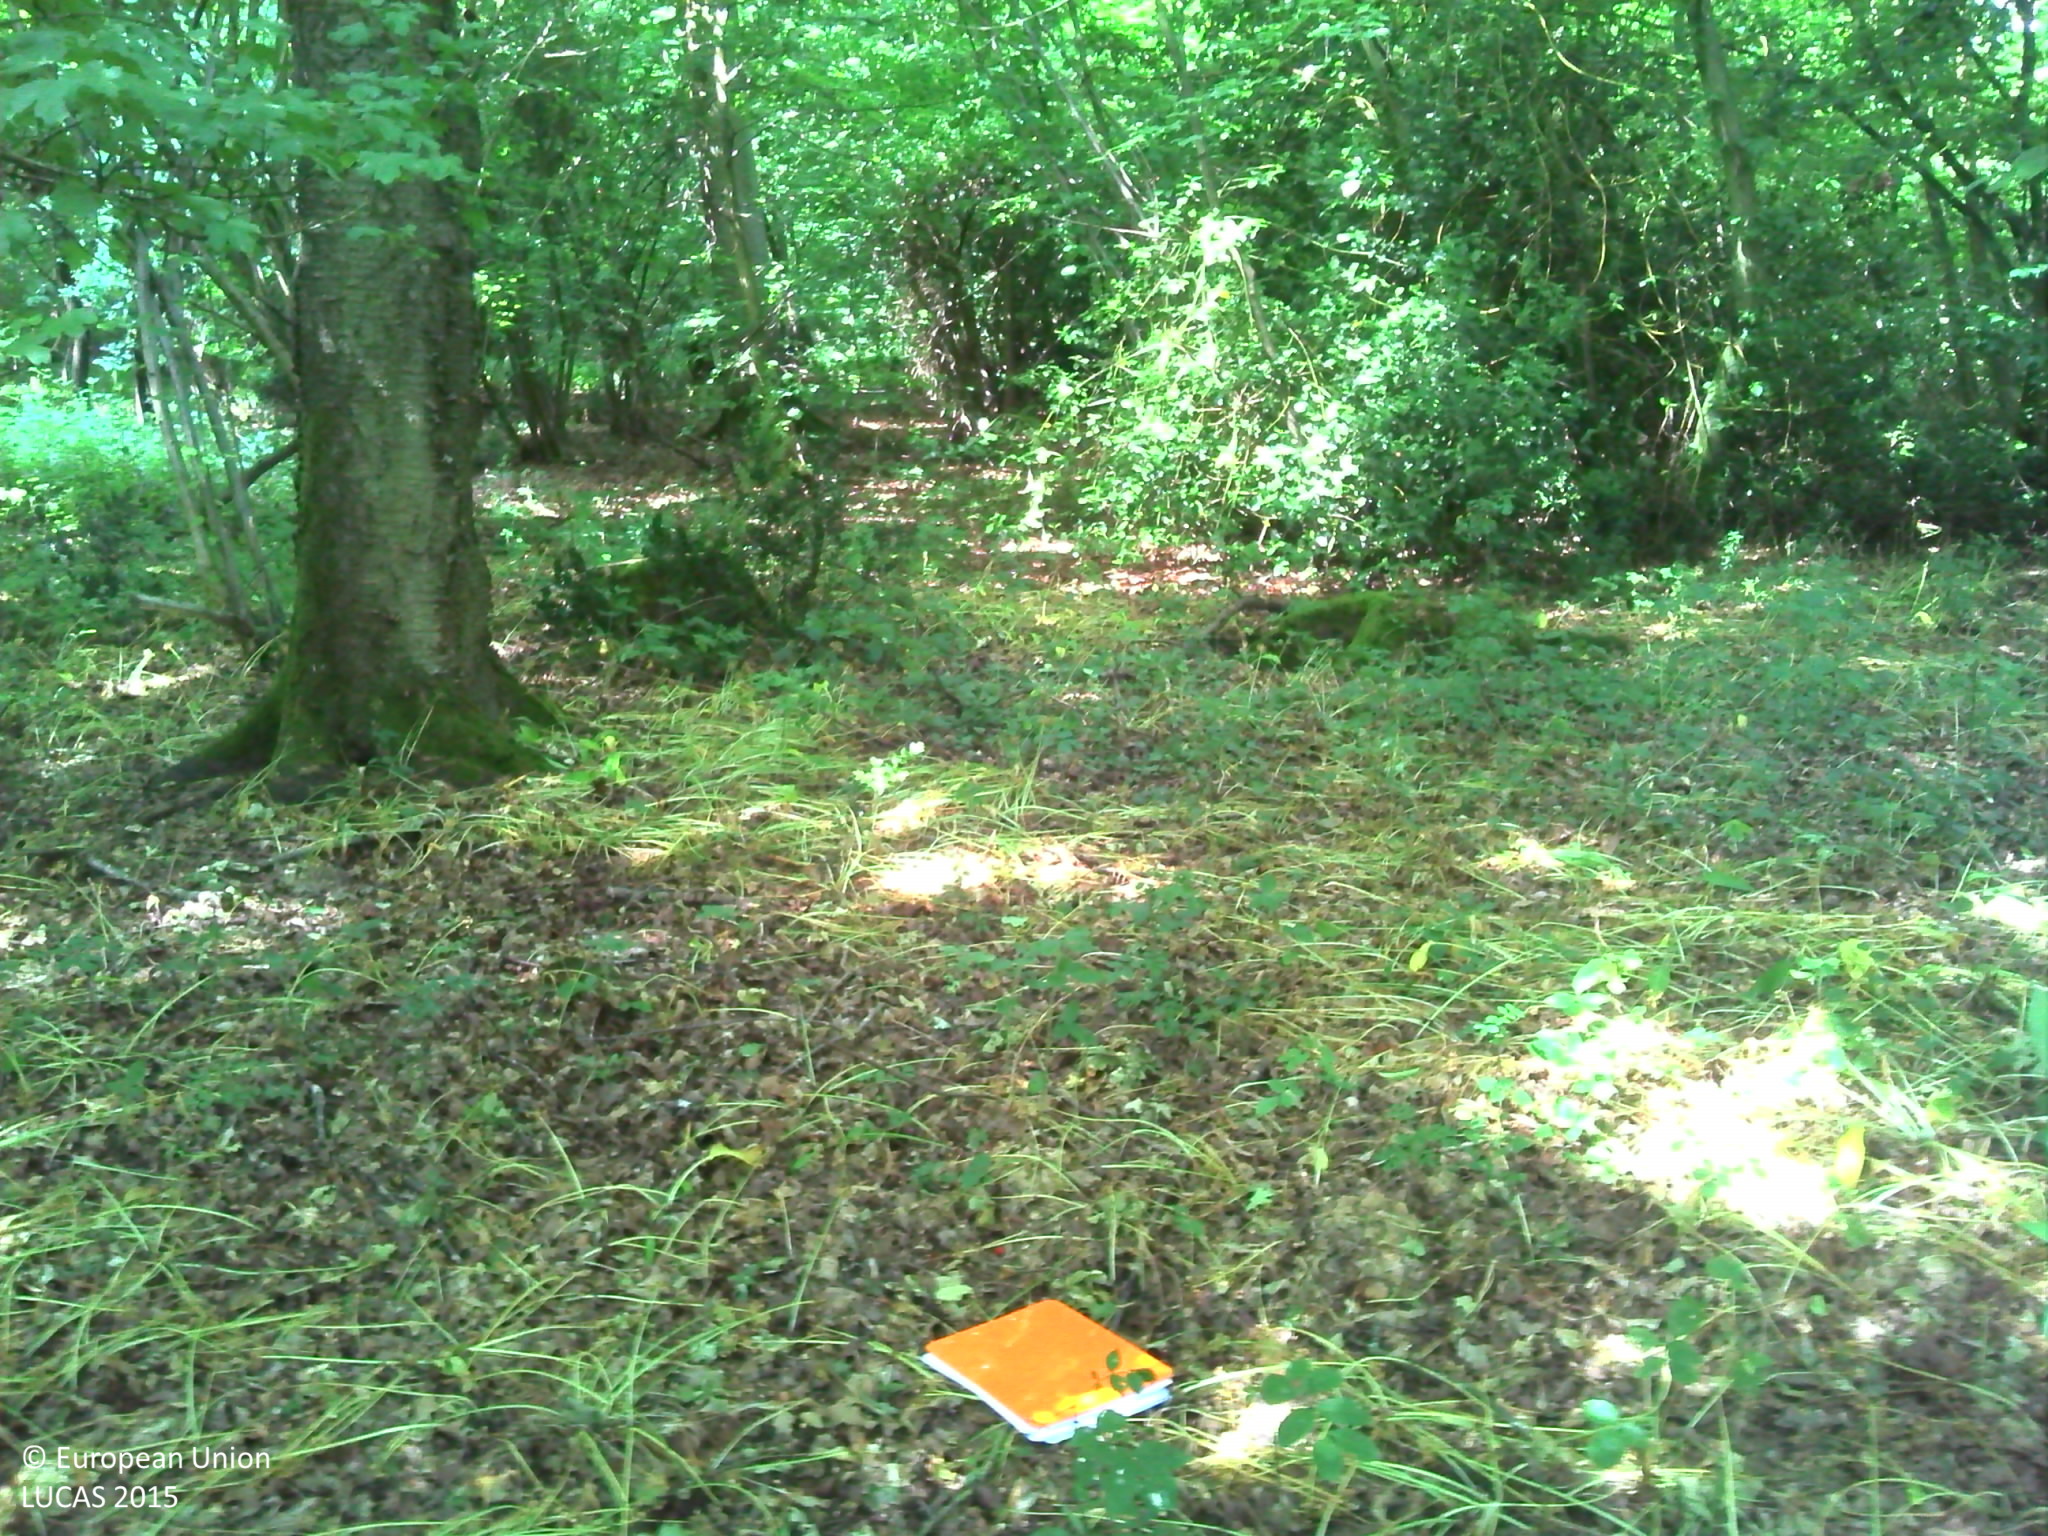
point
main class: Woodland
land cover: Broadleaved woodland
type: mesophytic deciduous forest
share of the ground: > 75 %
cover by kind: broadleaved forest trees 80 %, herbaceous plants 10 %, lichens and mosses 5 %, consolidated bare surface 5 %
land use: Forestry
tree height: > 5 m
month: June
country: FR
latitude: 49.1887
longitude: 1.1568
